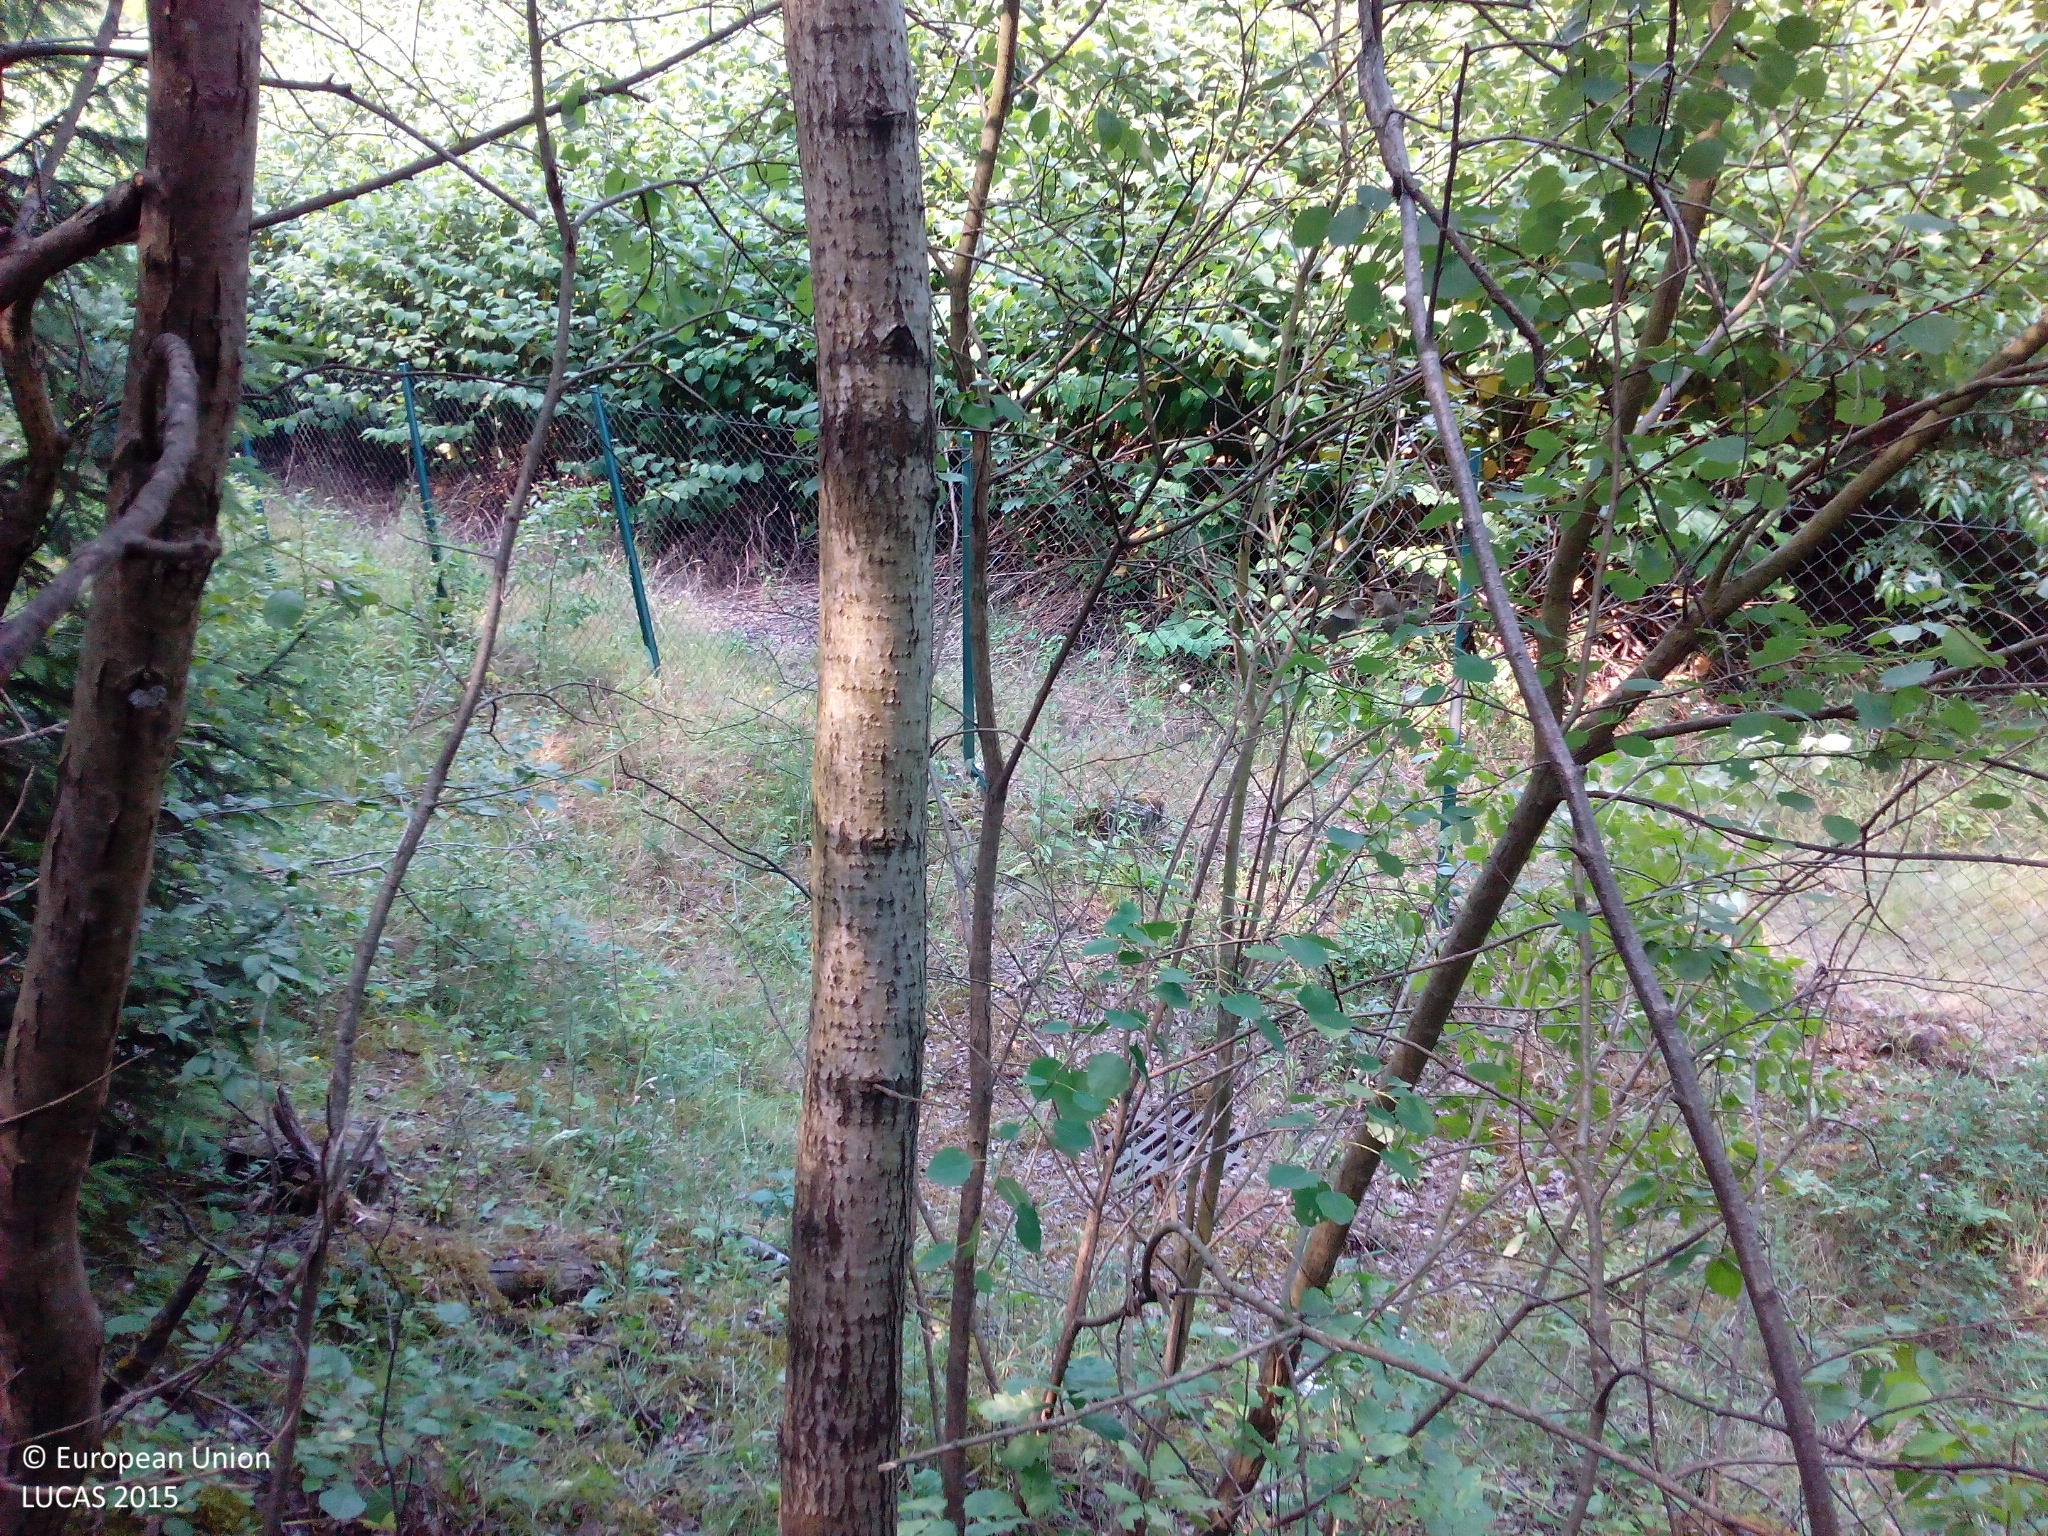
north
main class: Woodland
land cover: Other mixed woodland
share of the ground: > 75 %
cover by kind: coniferous forest trees 75 %, broadleaved forest trees 25 %
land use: Semi-natural and natural areas not in use
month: July
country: DE
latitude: 49.3389
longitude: 7.1515
